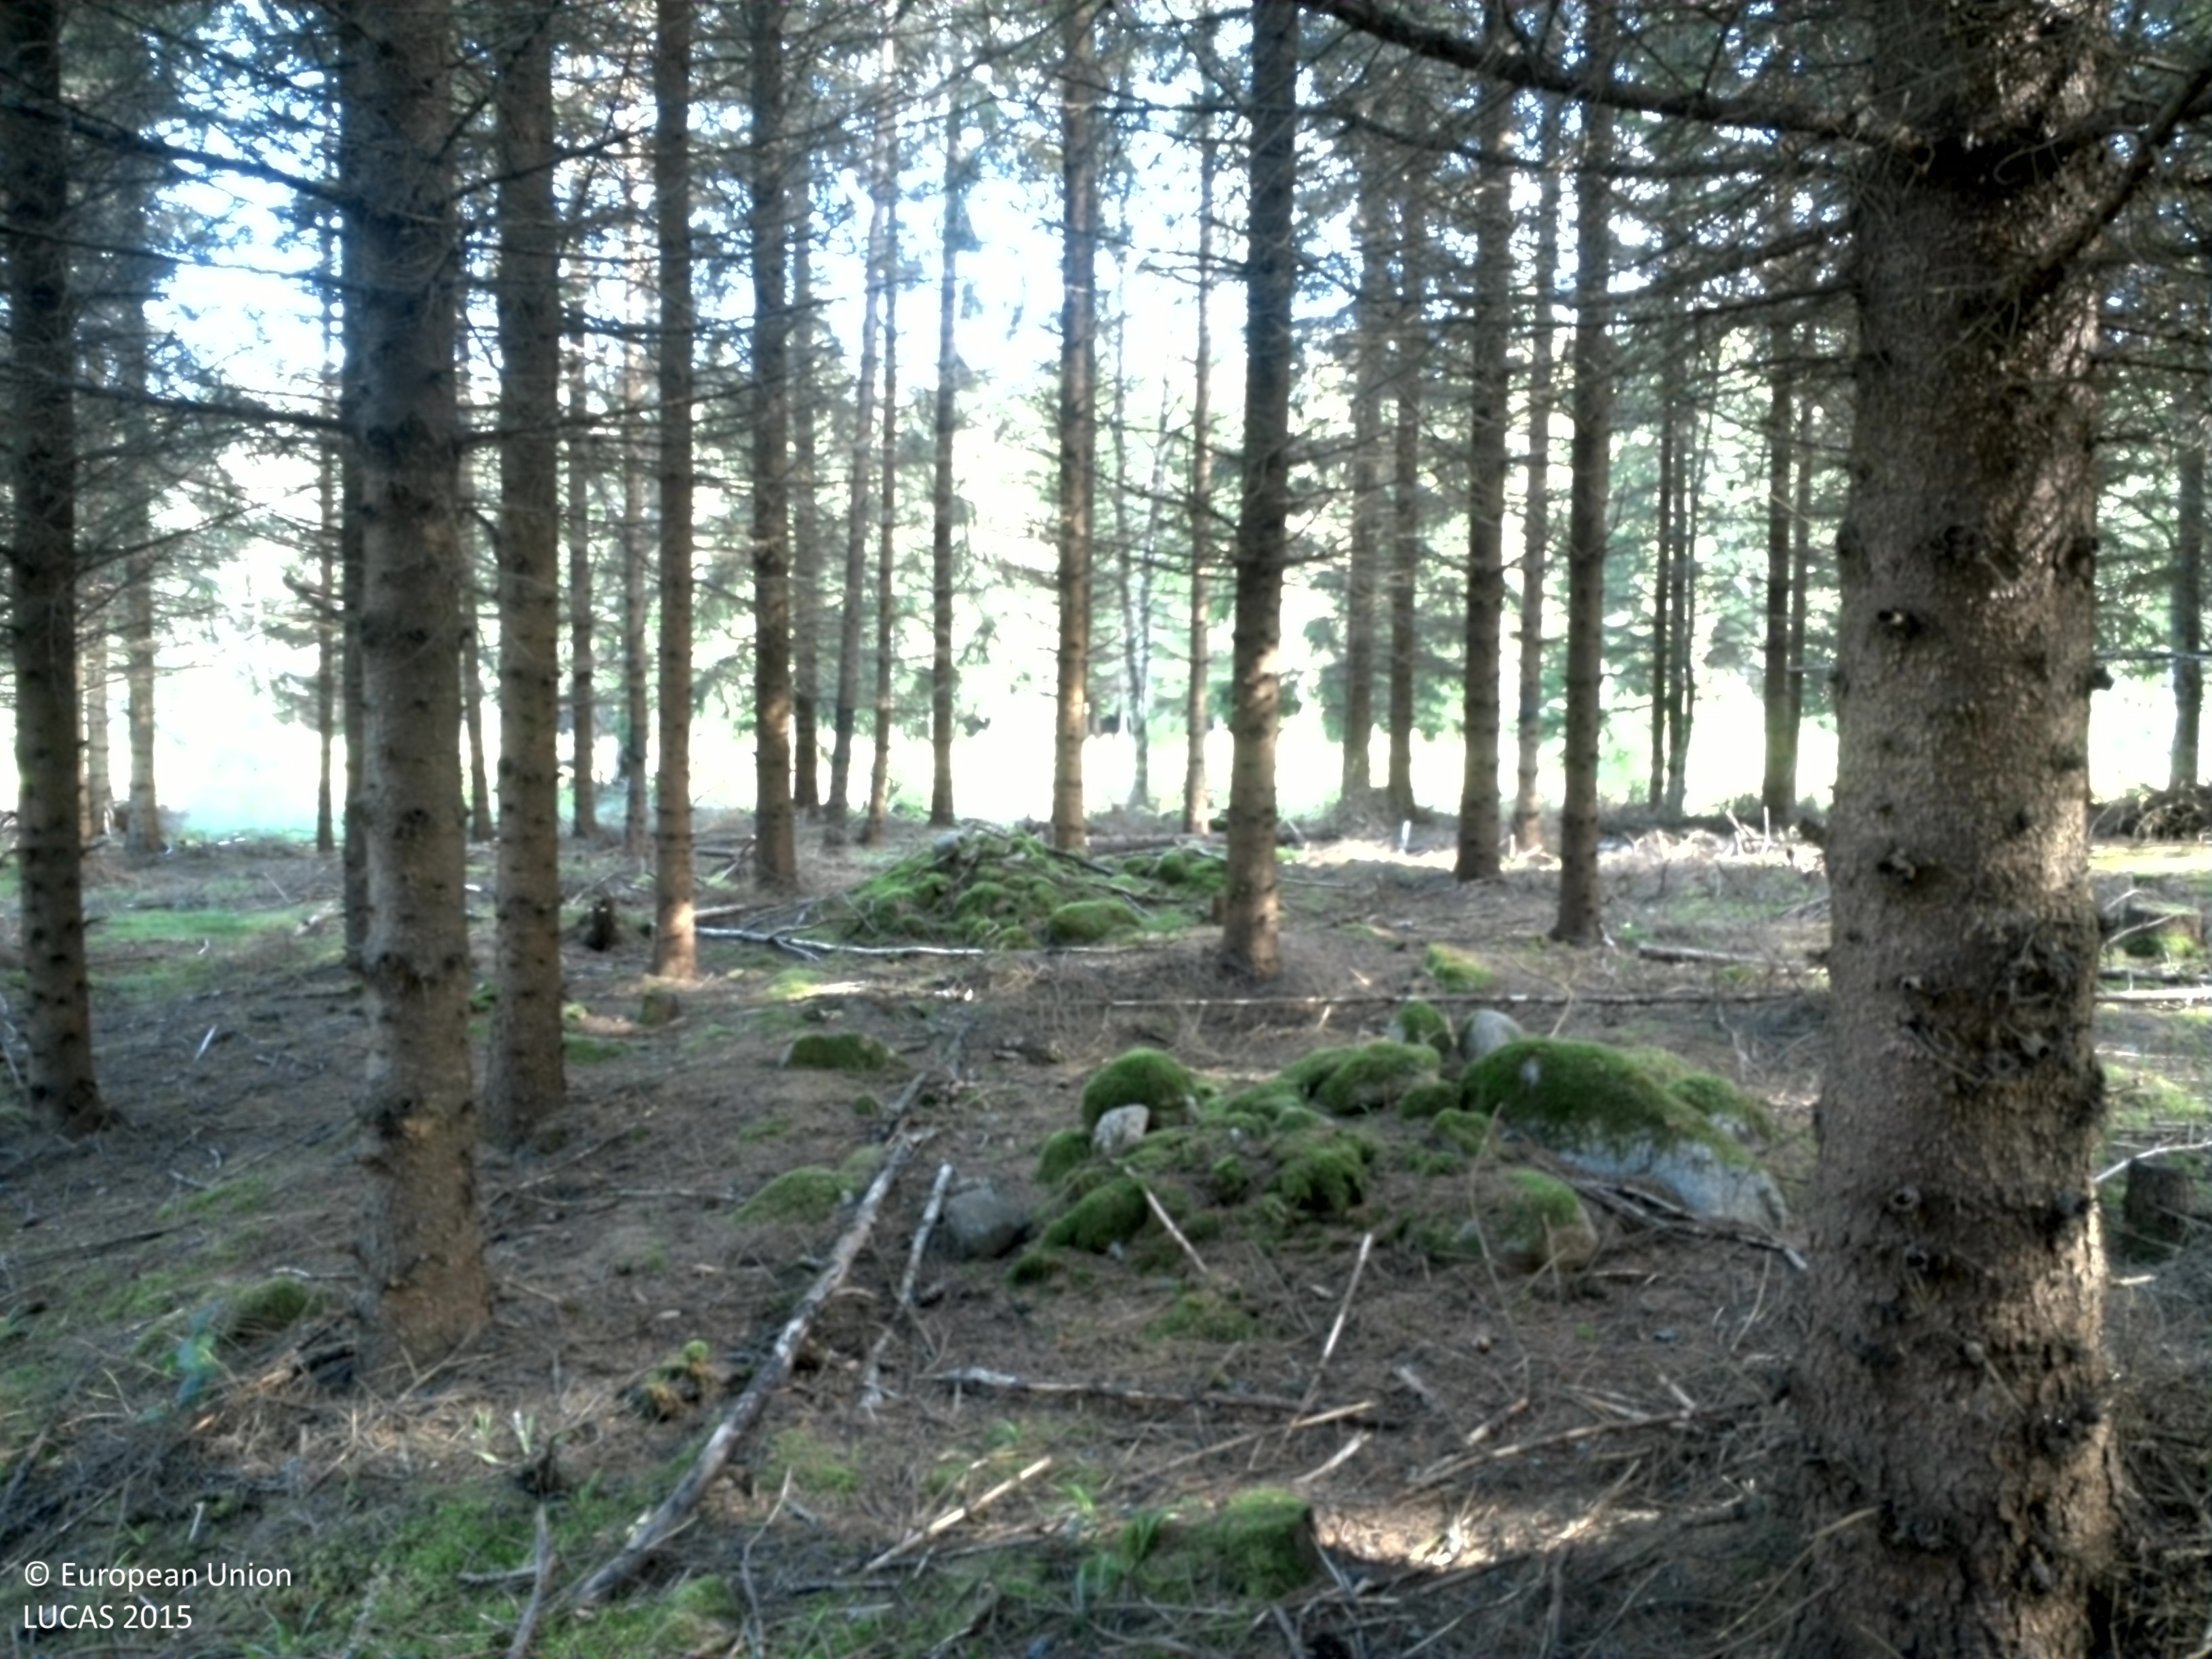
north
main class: Woodland
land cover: Spruce dominated coniferous woodland
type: boreal forest
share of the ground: > 75 %
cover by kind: coniferous forest trees 90 %, lichens and mosses 5 %, unconsolidated bare surface 5 %
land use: Forestry
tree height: > 5 m
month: August
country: SE
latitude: 58.1779
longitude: 13.3443
